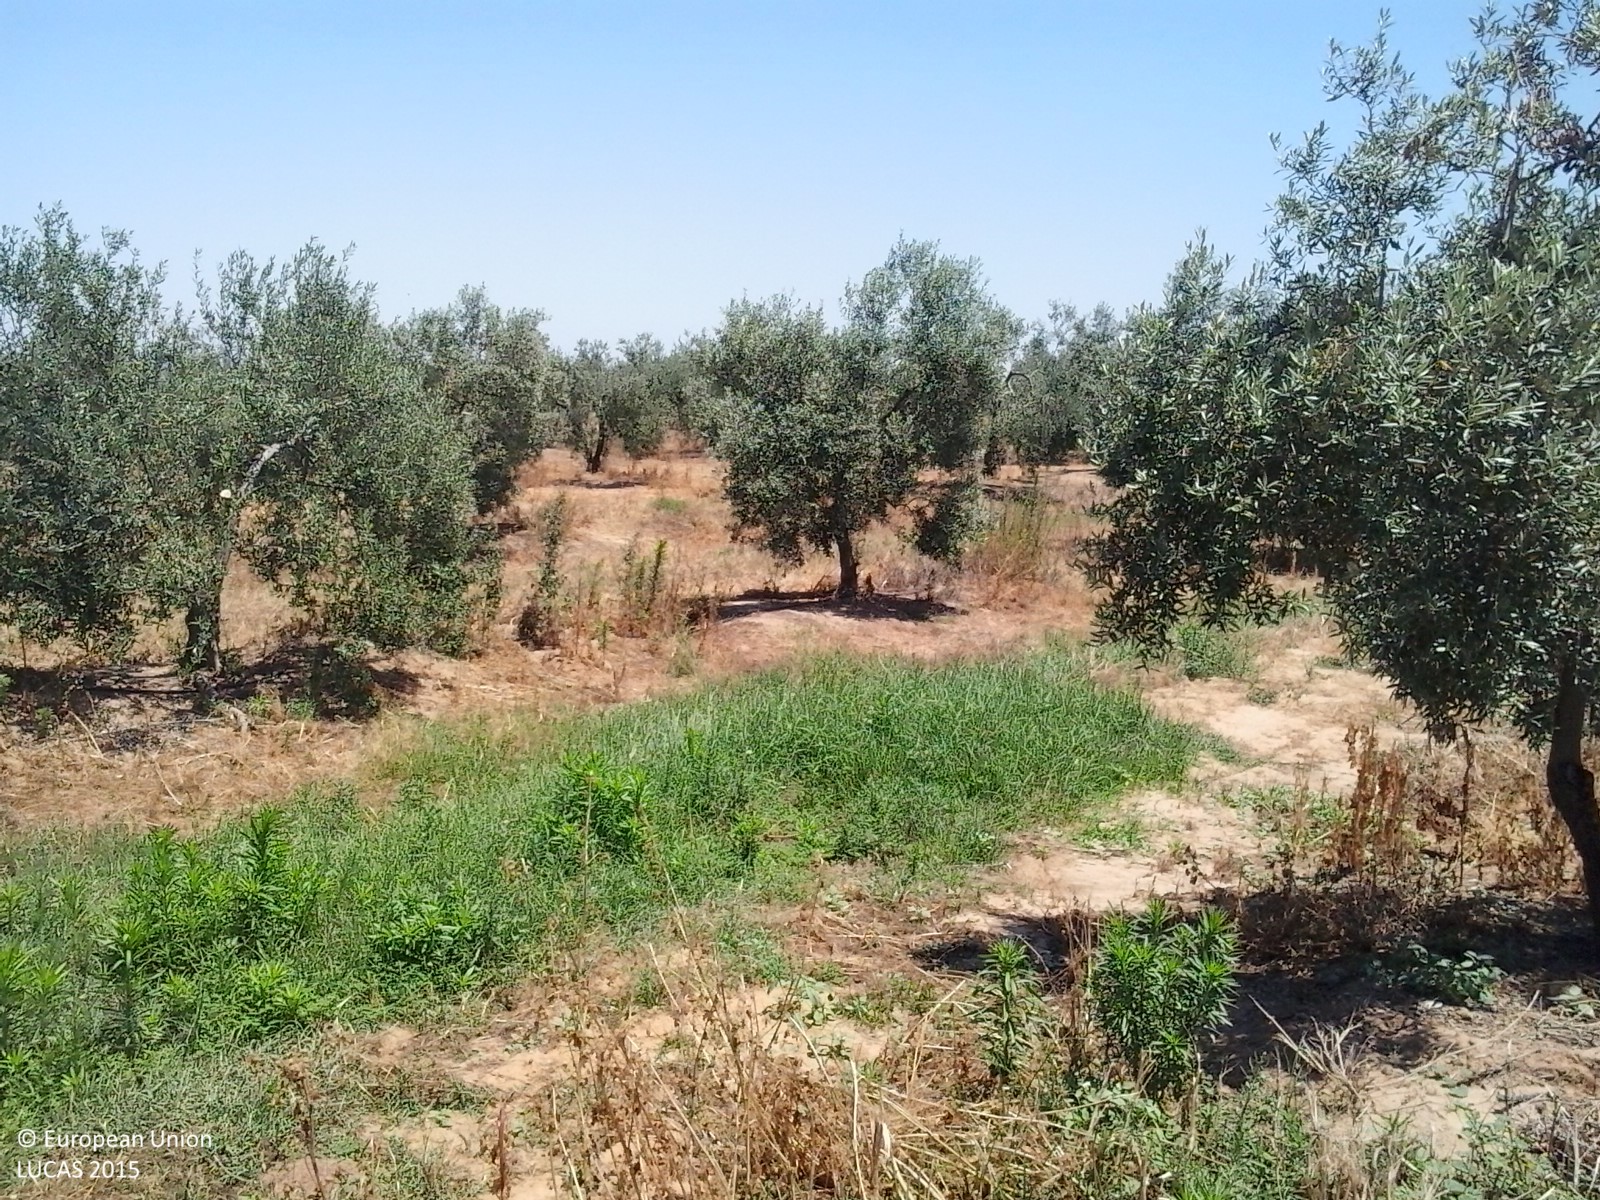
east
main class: Cropland
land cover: Olive groves
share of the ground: 10 - 25 %
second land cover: Spontaneously vegetated surfaces
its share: 50 - 75 %
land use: Agriculture (excluding fallow land and kitchen gardens)
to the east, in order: Olive groves; Spontaneously vegetated surfaces
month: June
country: ES
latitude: 37.3527
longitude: -6.3651
